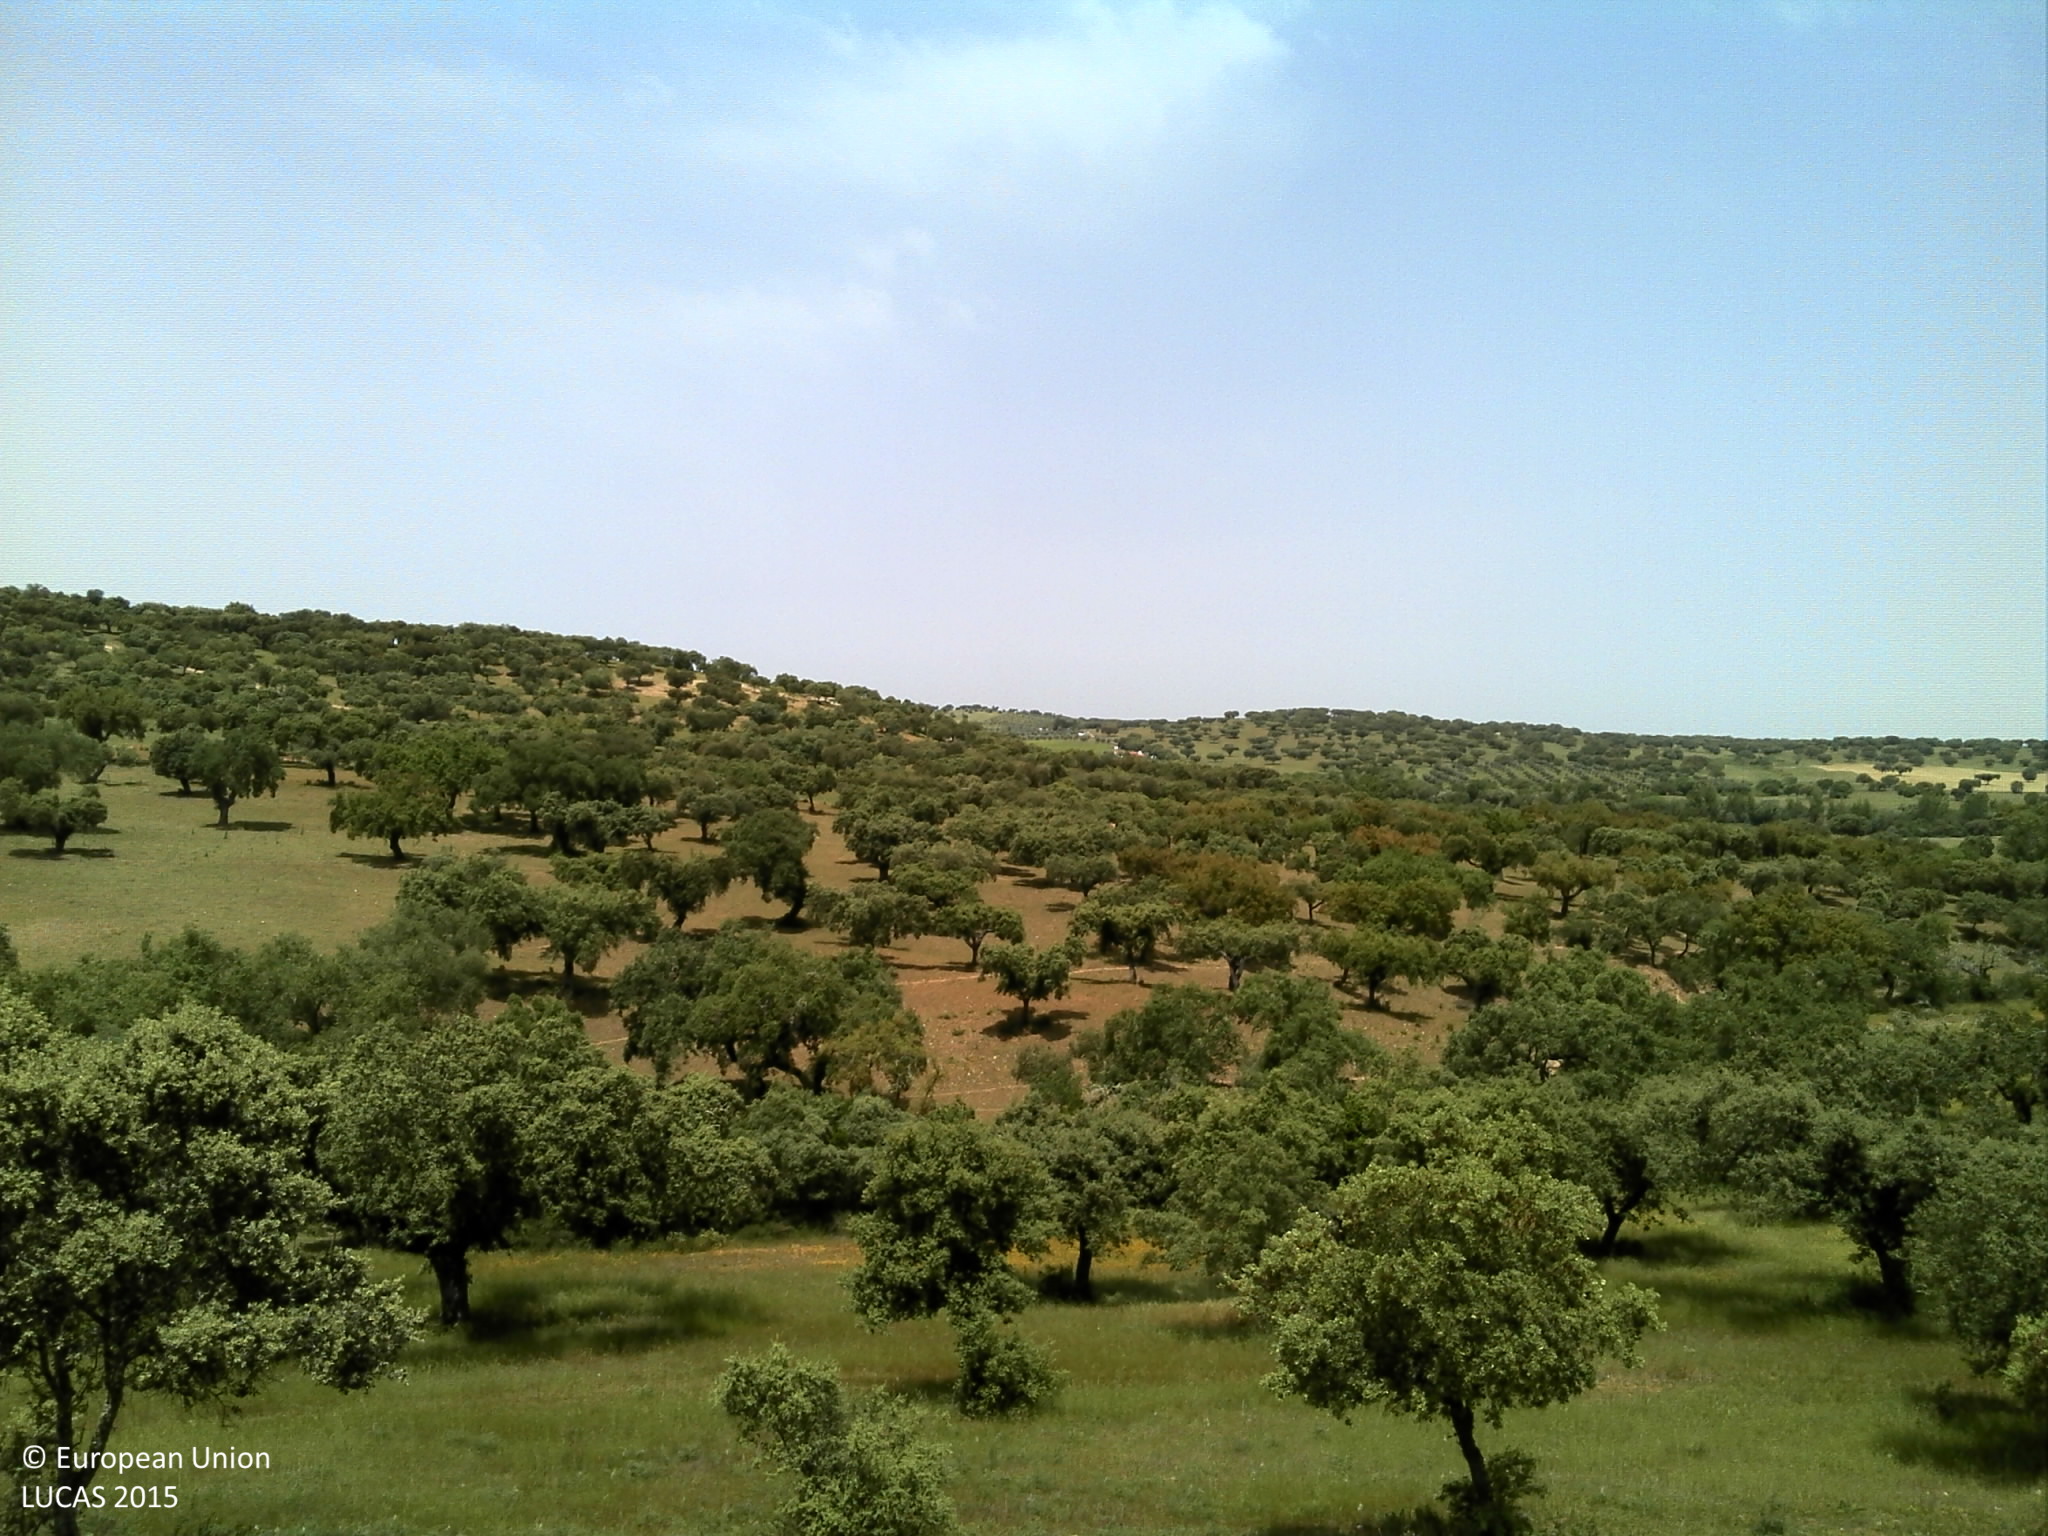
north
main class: Woodland
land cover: Broadleaved woodland
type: broadleaved evergreen forest
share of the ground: 50 - 75 %
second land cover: Grassland without tree/shrub cover
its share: 10 - 25 %
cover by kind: broadleaved forest trees 60 %, herbaceous plants 25 %, unconsolidated bare surface 15 %
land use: Forestry
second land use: Agriculture (excluding fallow land and kitchen gardens)
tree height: > 5 m
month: May
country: PT
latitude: 39.0142
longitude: -7.8907
